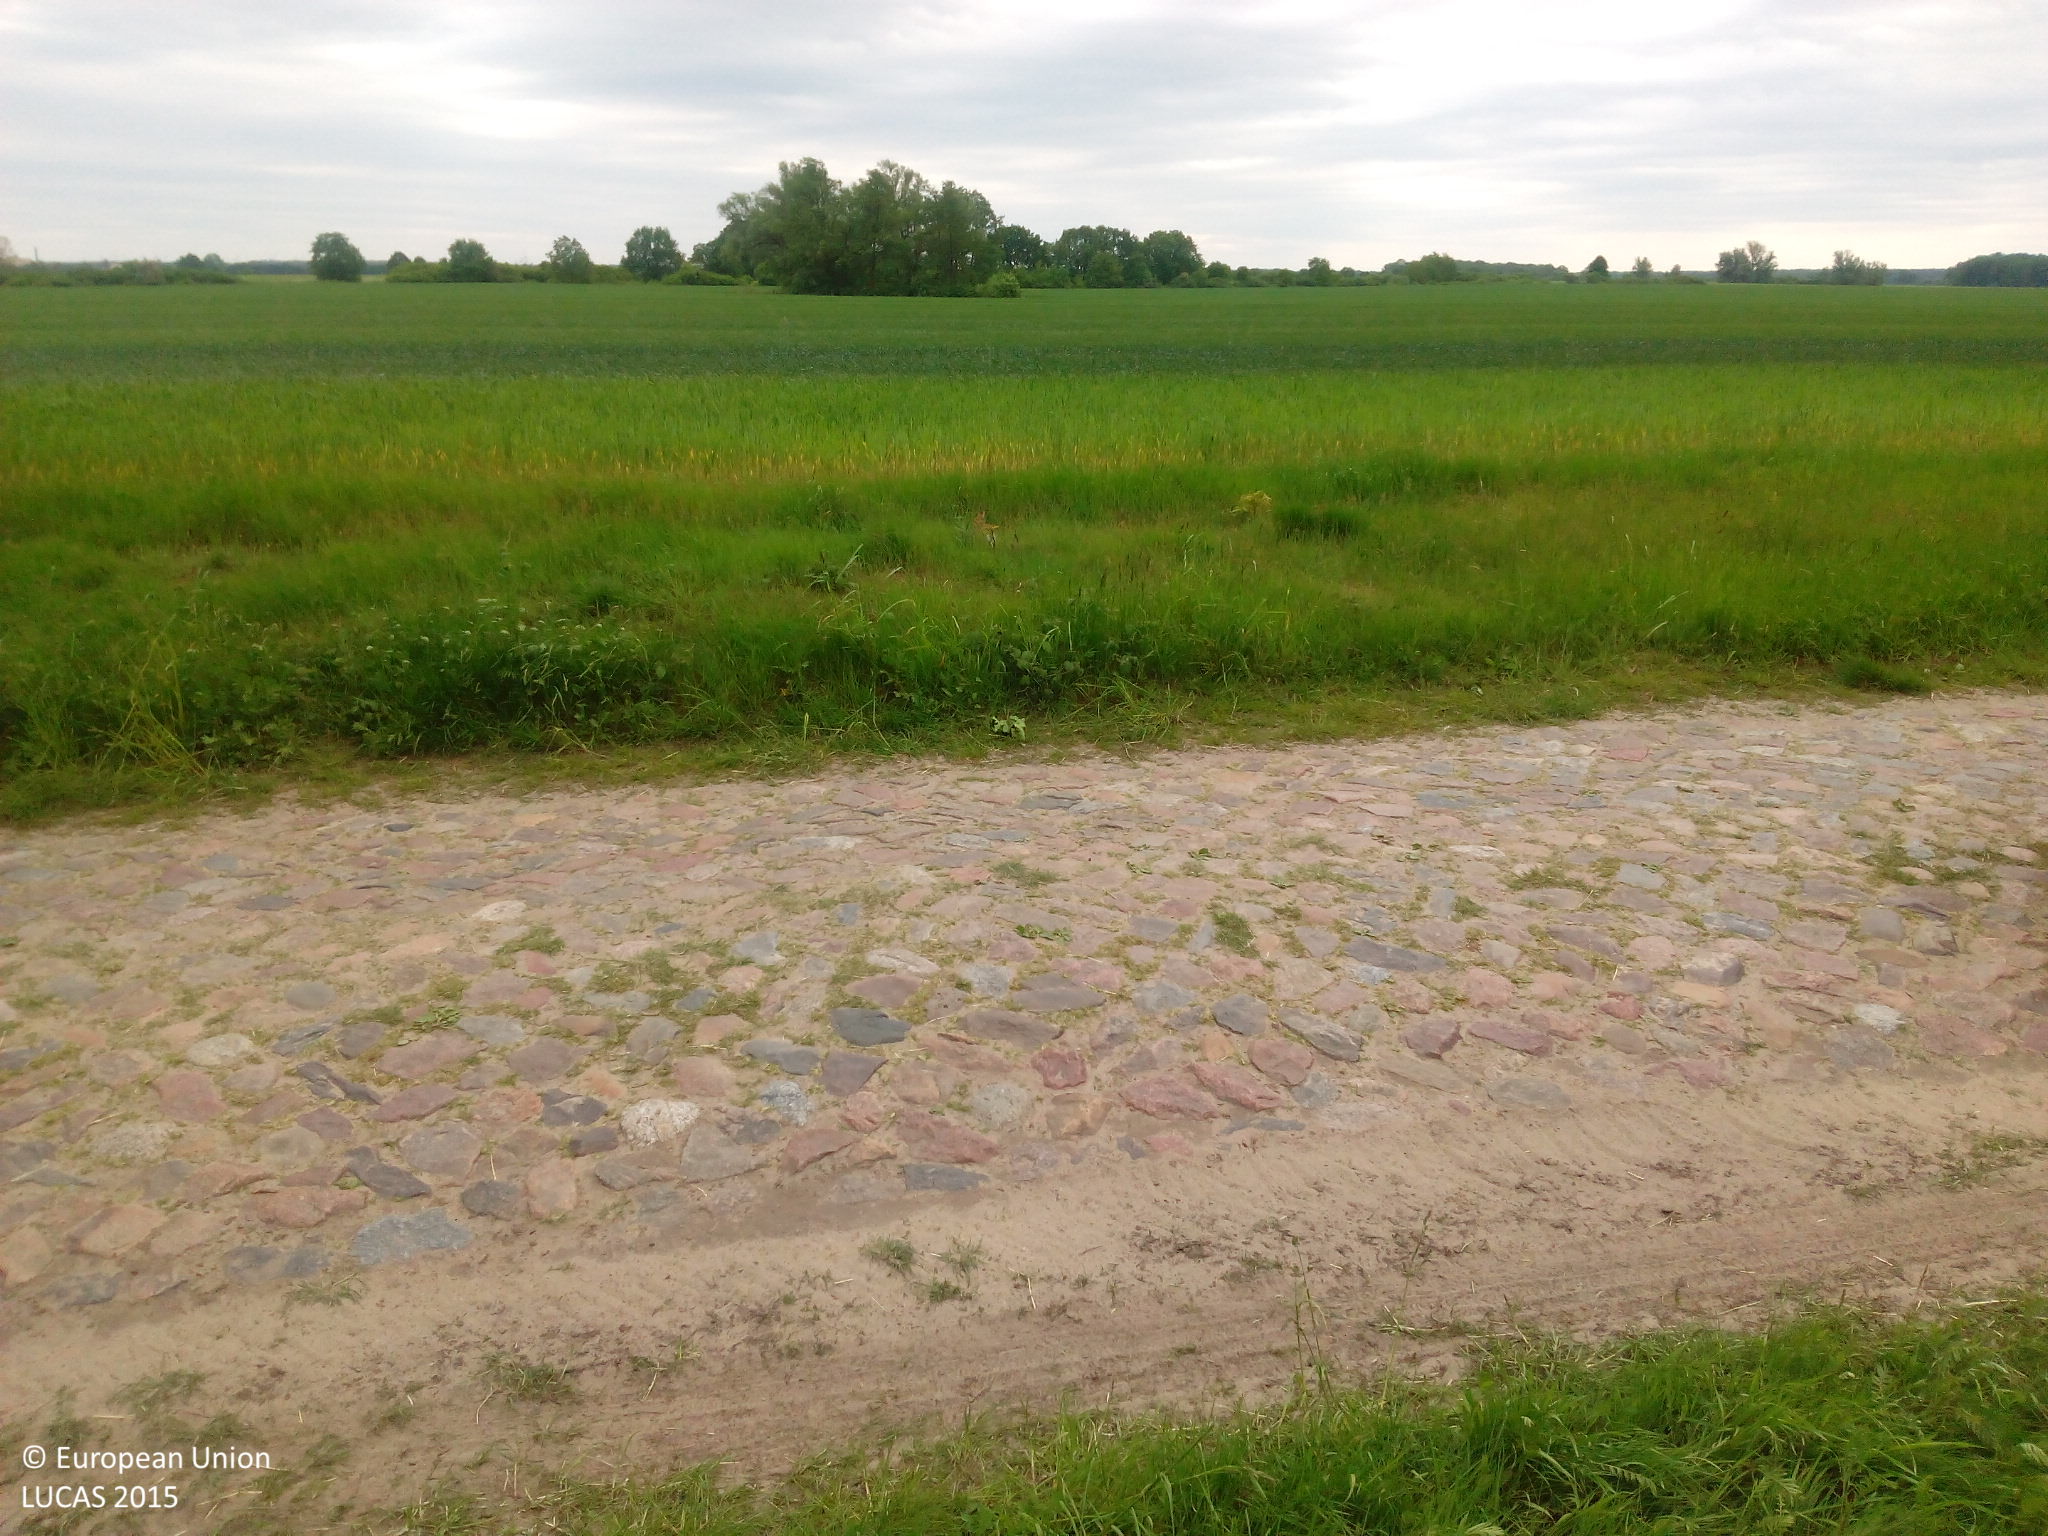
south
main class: Cropland
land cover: Rape and turnip rape
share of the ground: > 75 %
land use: Agriculture (excluding fallow land and kitchen gardens)
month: June
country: DE
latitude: 53.2454
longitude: 11.7527
